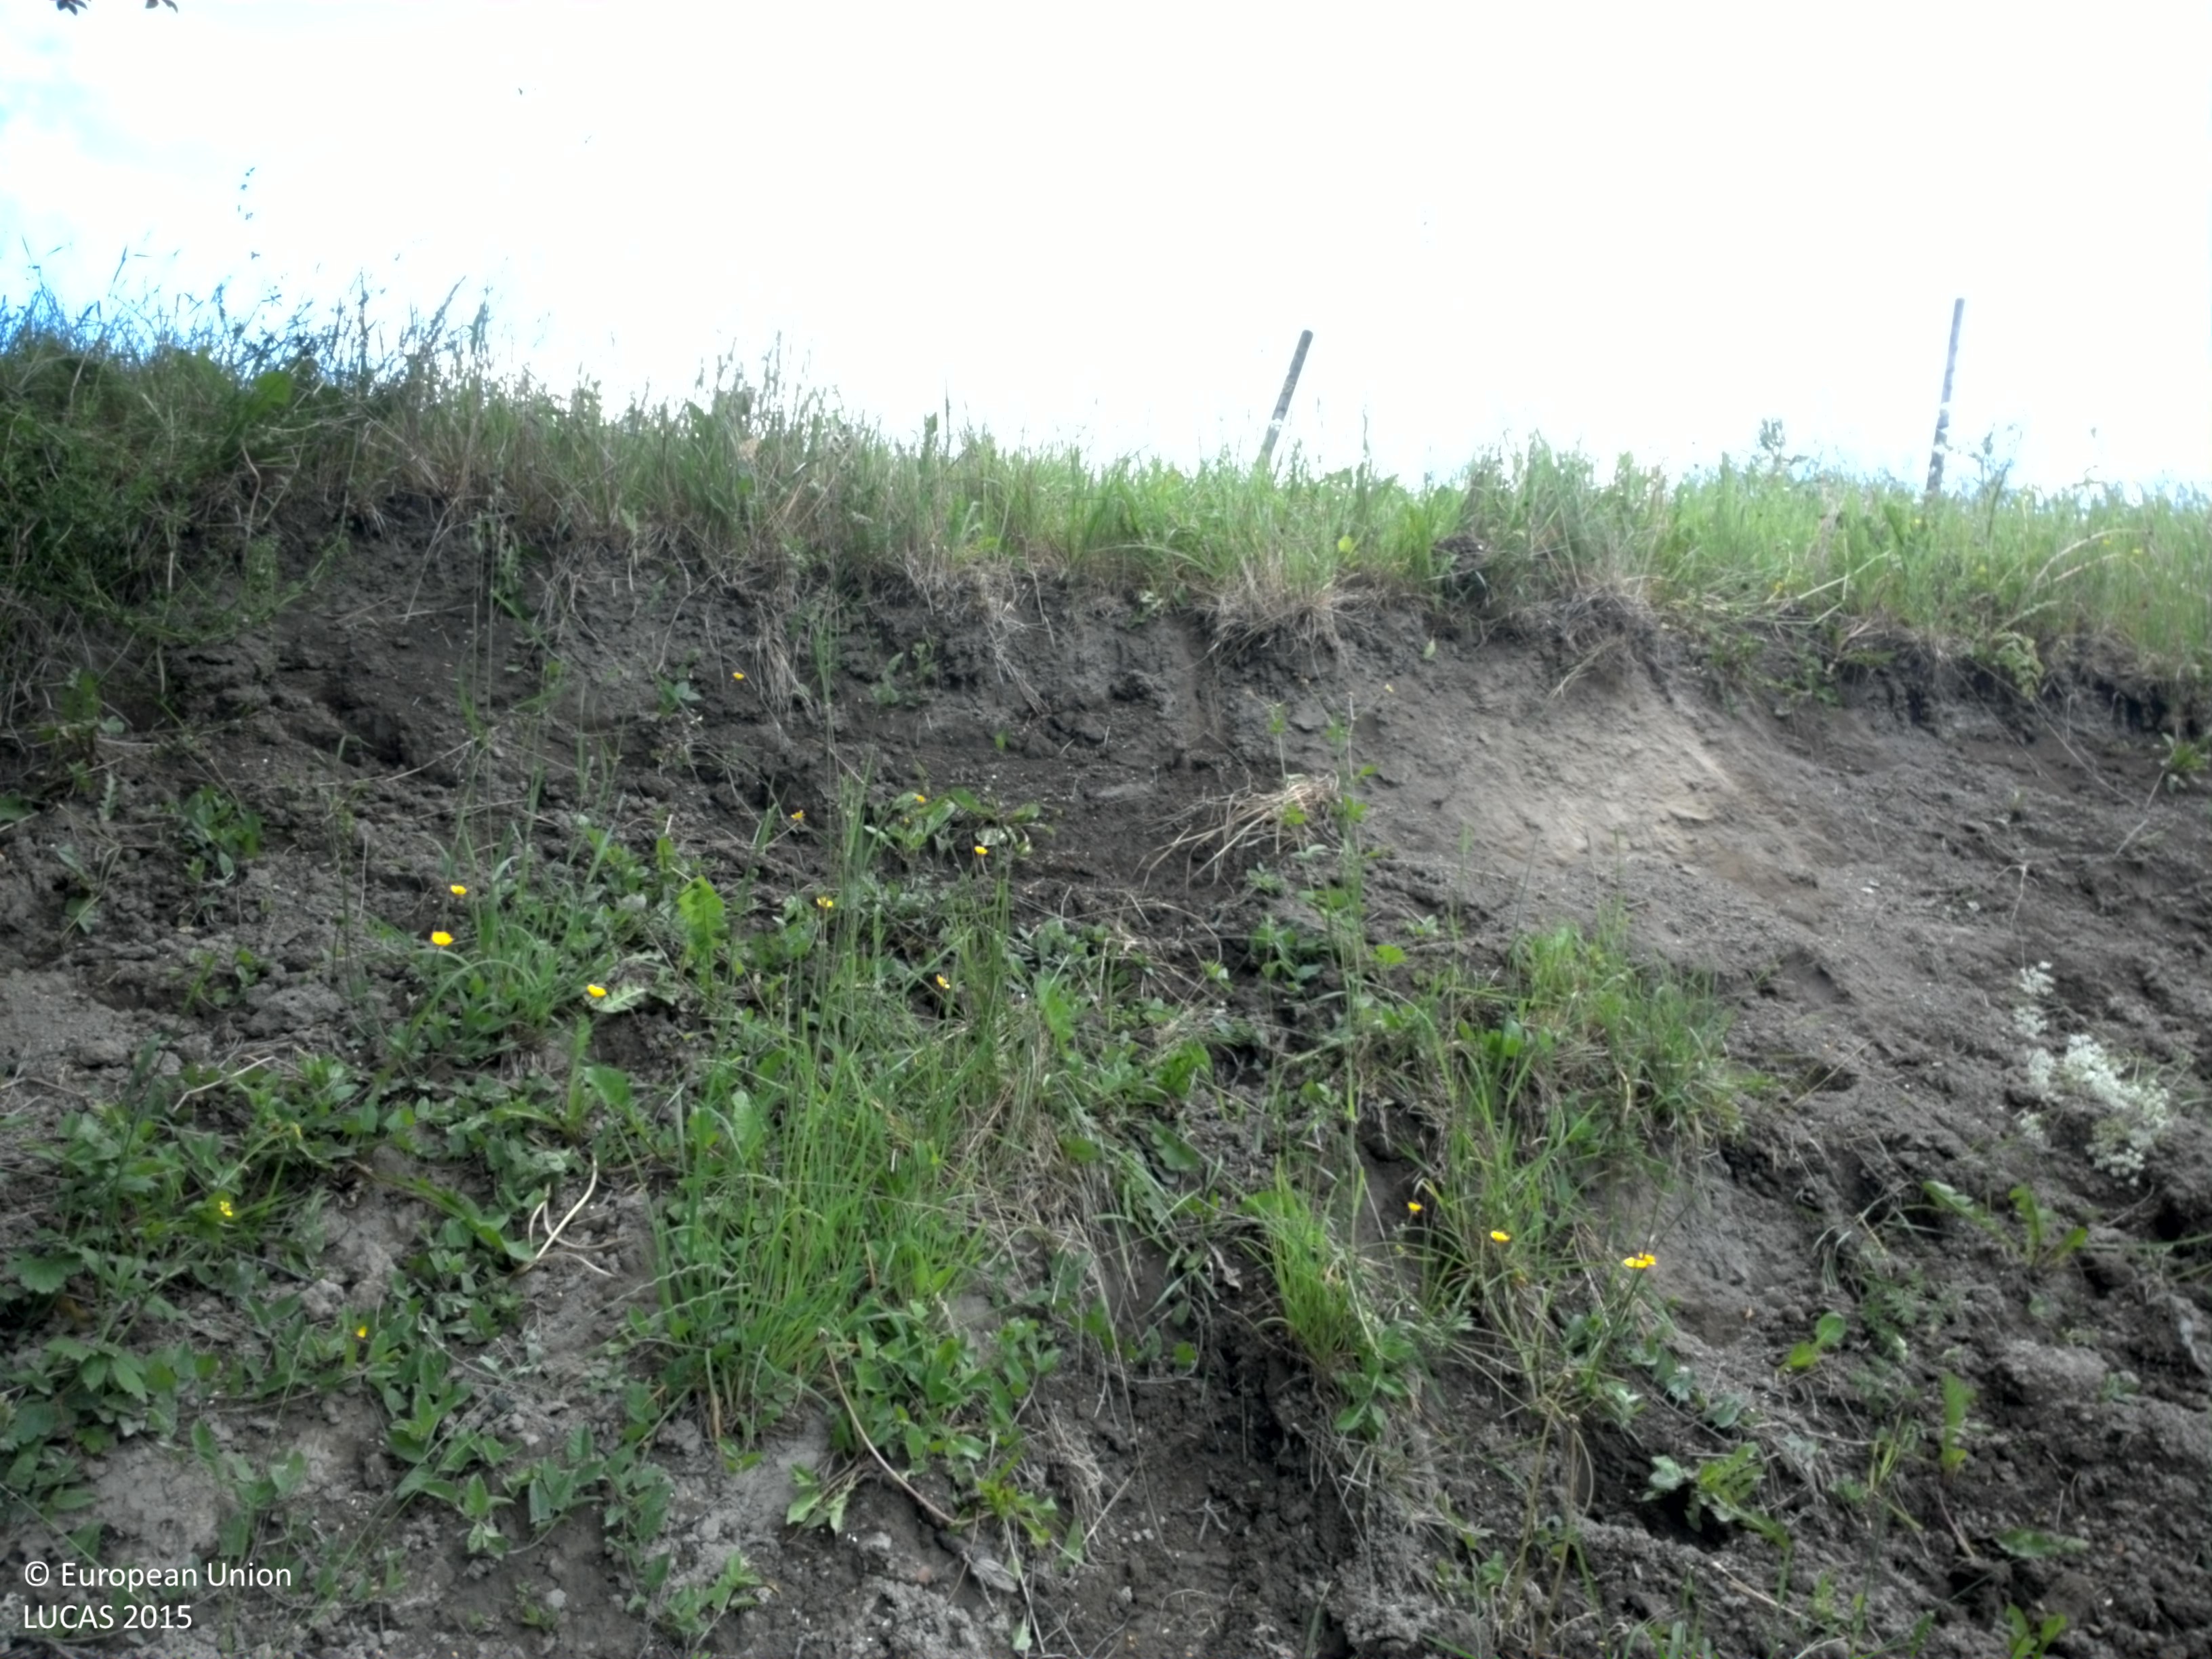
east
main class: Grassland
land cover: Grassland without tree/shrub cover
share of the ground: > 75 %
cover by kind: herbaceous plants 95 %, shrubs 5 %
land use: Agriculture (excluding fallow land and kitchen gardens)
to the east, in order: Grassland without tree/shrub cover; Abandoned hedges; Rivers and streams; Abandoned hedges; Grassland with sparse tree/shrub cover; Fences; Clovers; Ditches and canals; Paved roads, cycling and walking lanes; Ditches and canals; Artificial constructions in urban areas
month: June
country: SE
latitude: 59.9254
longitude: 17.5253
